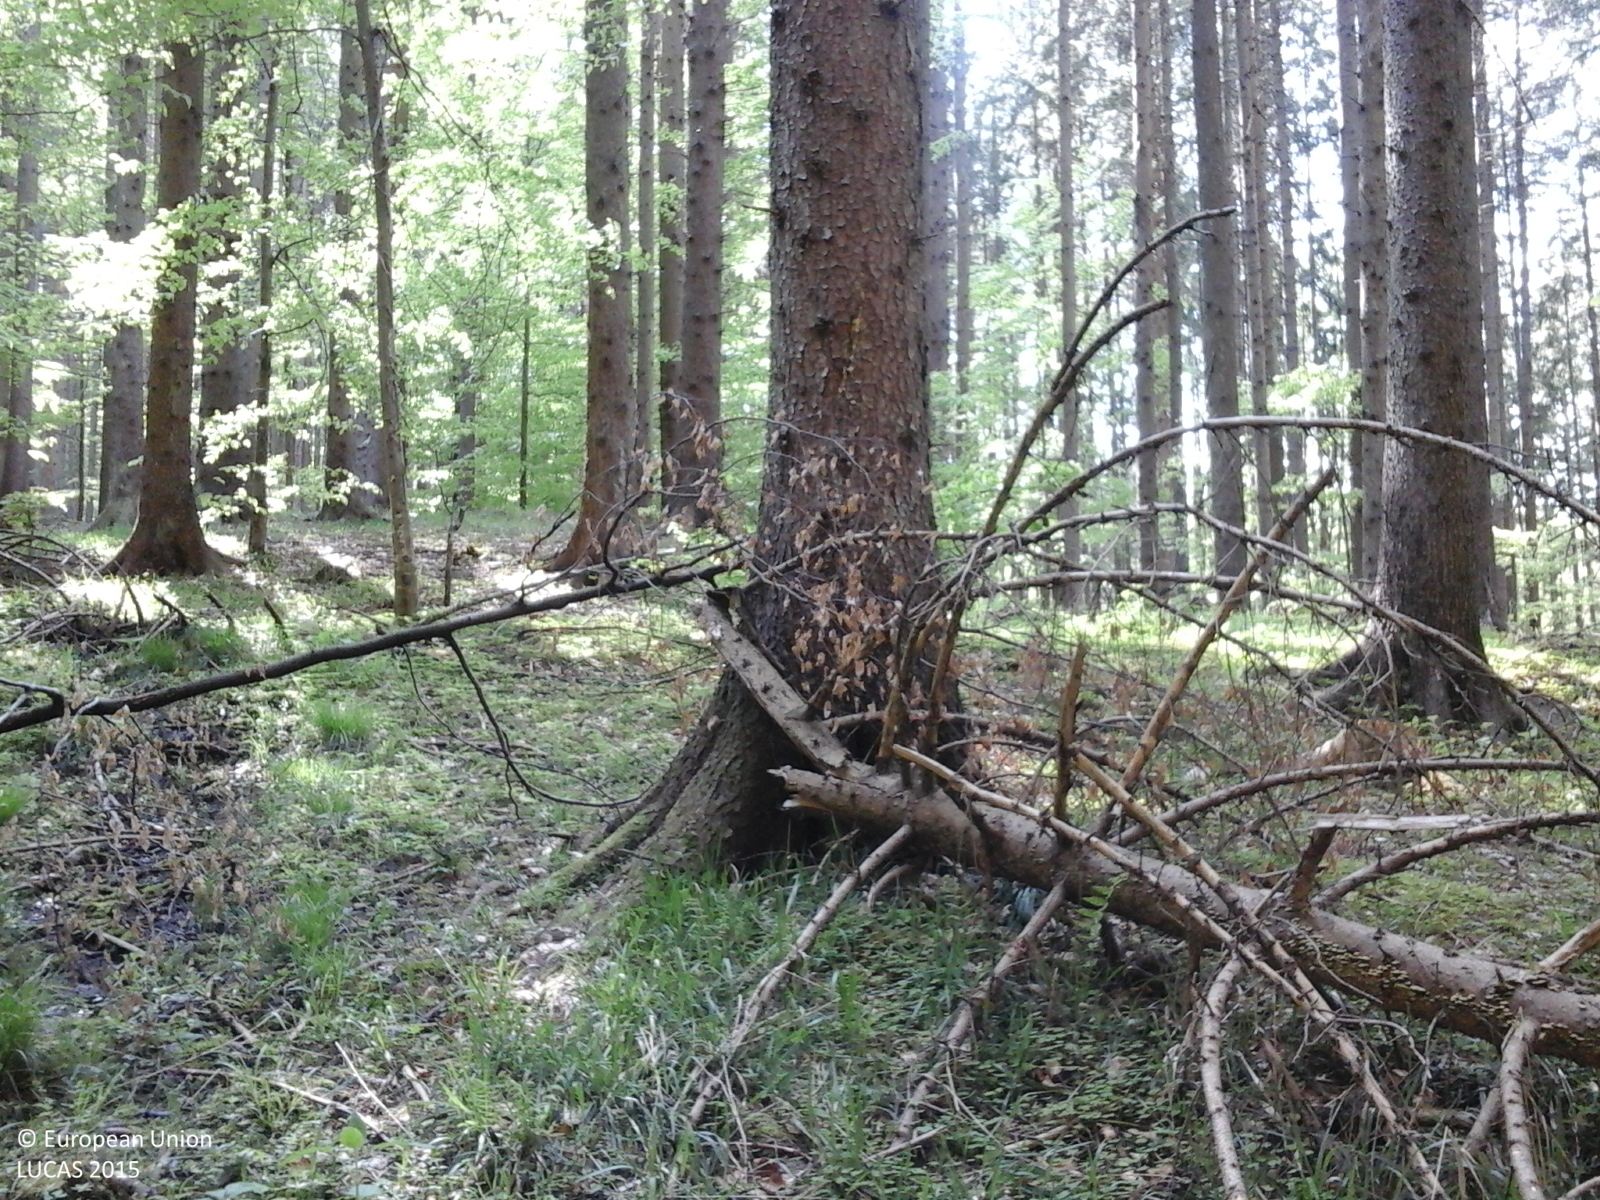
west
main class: Woodland
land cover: Spruce dominated coniferous woodland
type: hemiboreal forest and nemoral coniferous forest and mixed broadleaved-coniferous forest
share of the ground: > 75 %
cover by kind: coniferous forest trees 90 %, broadleaved forest trees 10 %
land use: Forestry
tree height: > 5 m
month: May
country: RO
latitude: 45.6564
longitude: 25.9623
